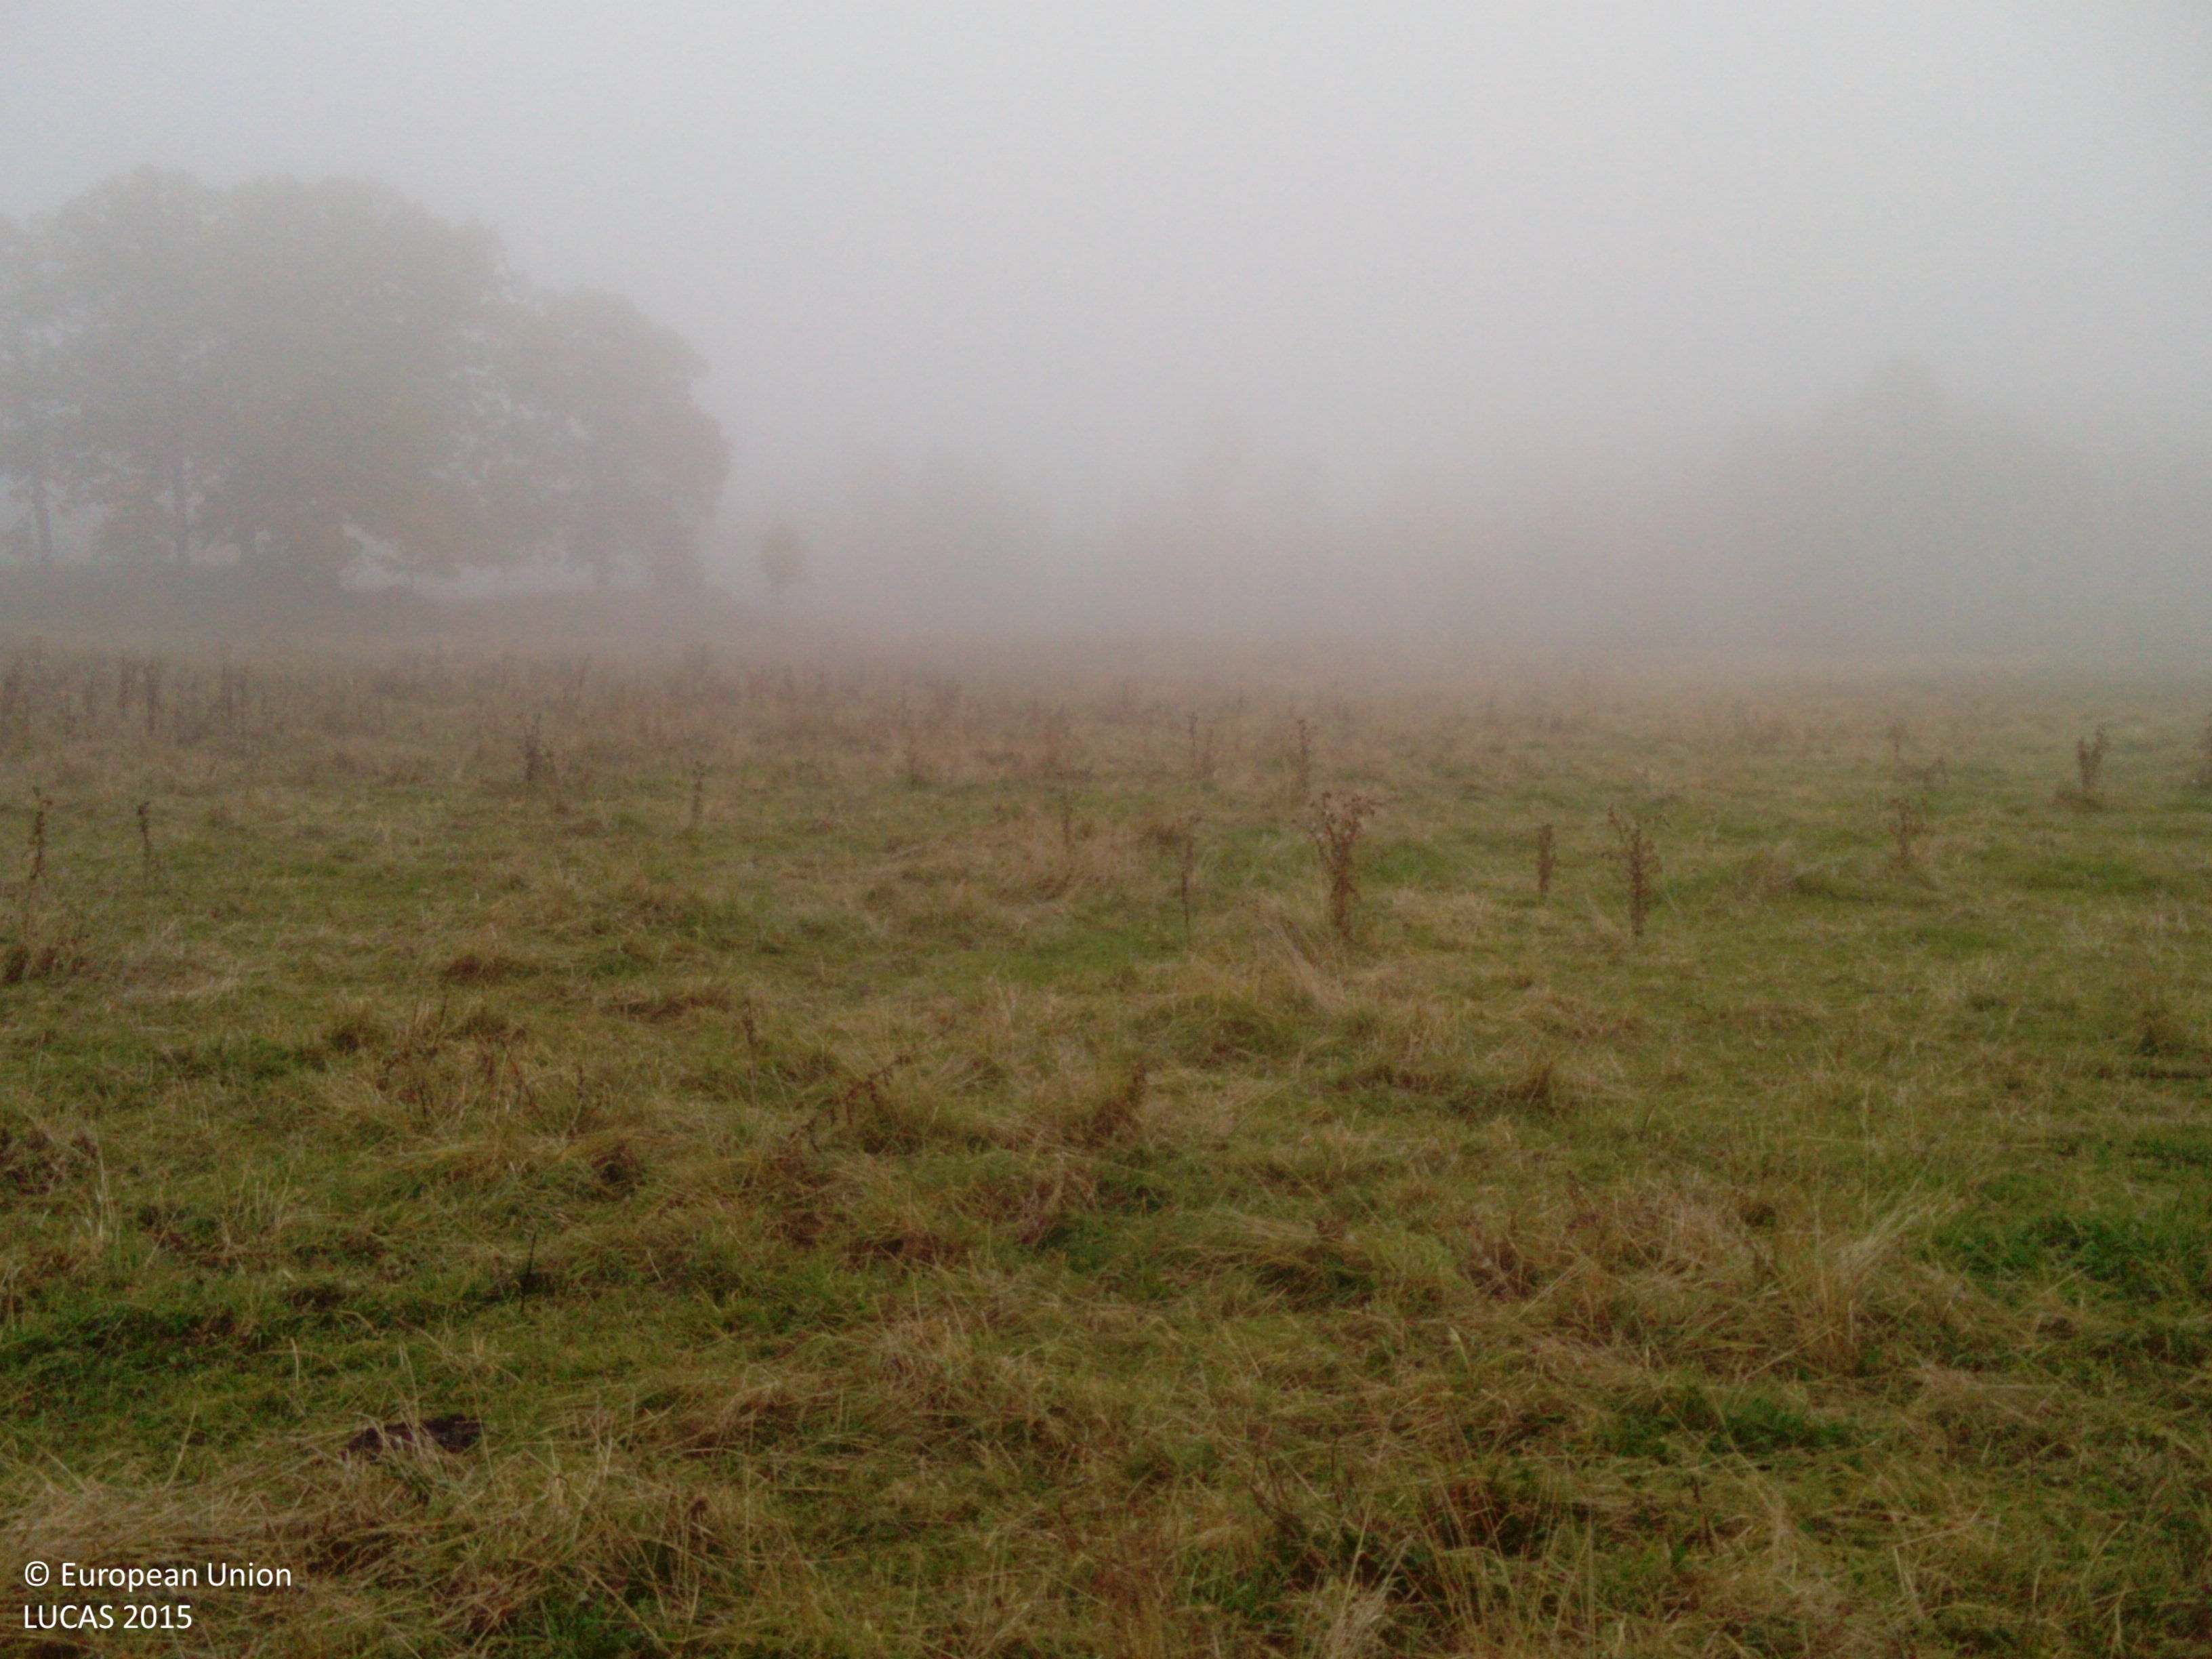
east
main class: Grassland
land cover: Grassland without tree/shrub cover
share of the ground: > 75 %
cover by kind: herbaceous plants 100 %
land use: Agriculture (excluding fallow land and kitchen gardens)
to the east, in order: Grassland without tree/shrub cover; Broadleaved woodland; Inland marshes
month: October
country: SE
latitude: 58.9301
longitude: 16.4744
